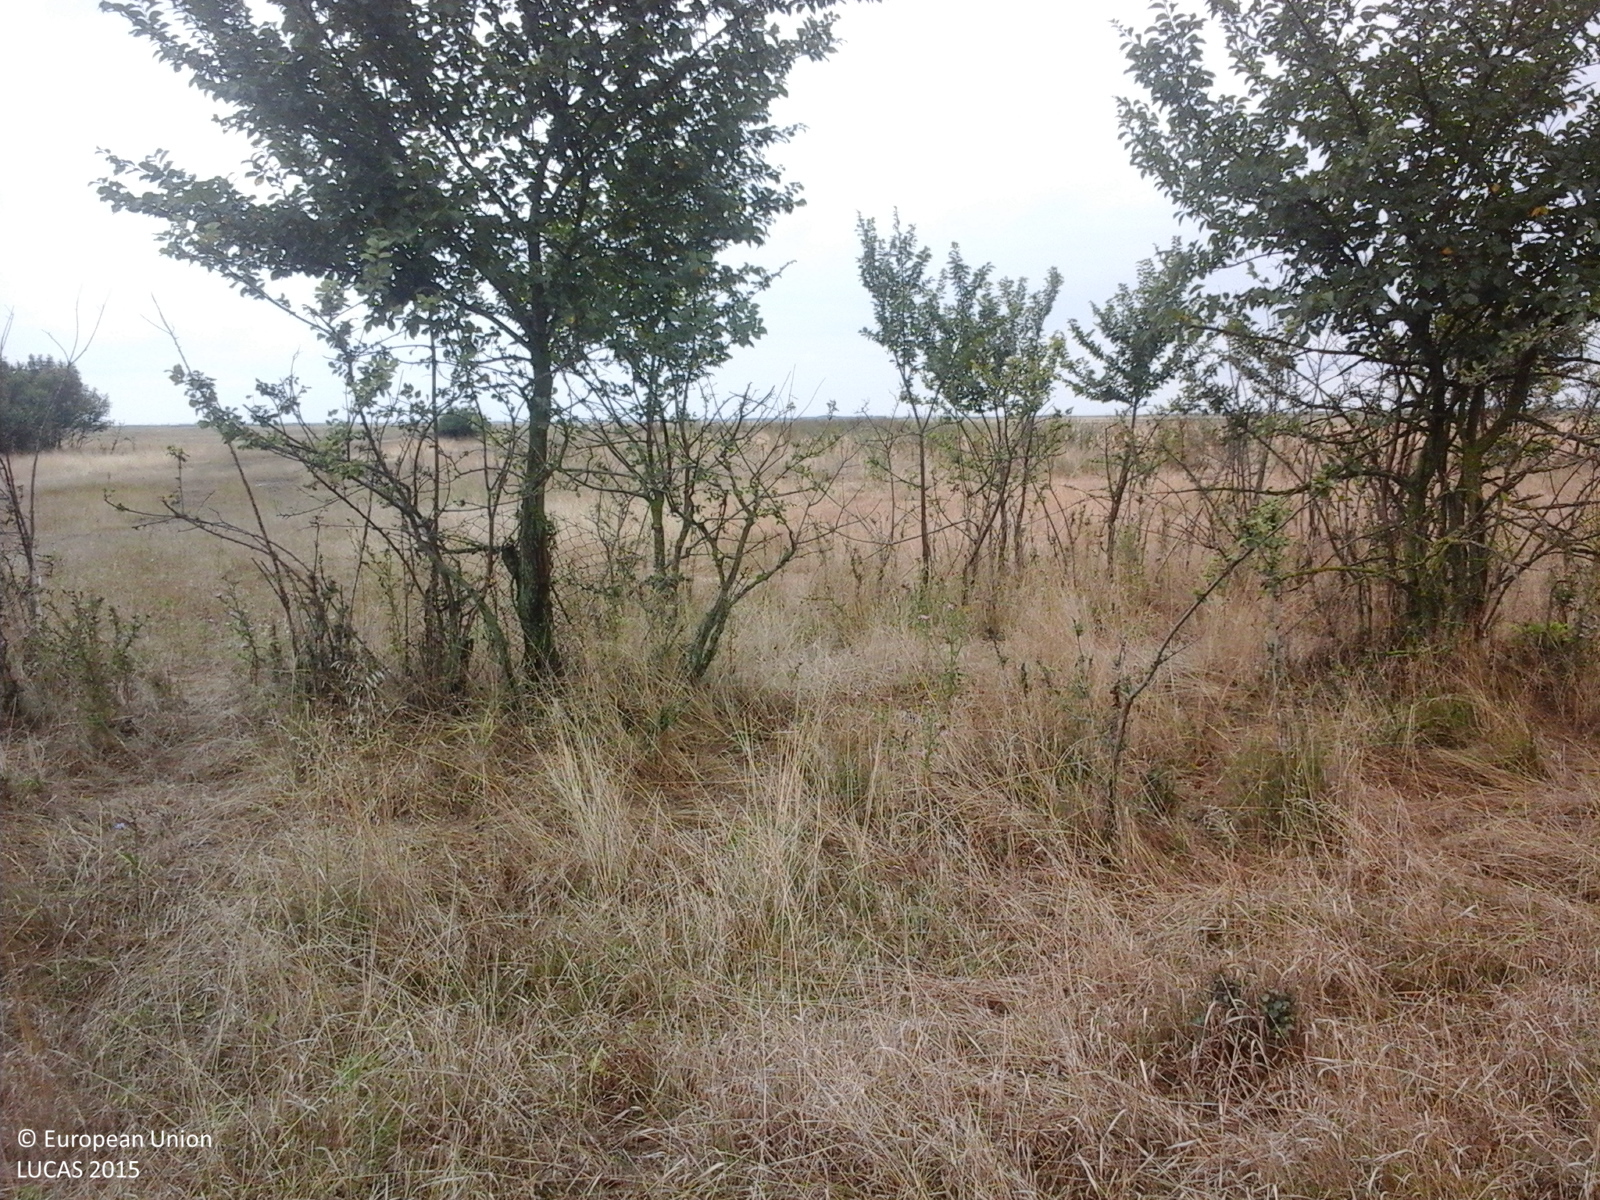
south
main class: Grassland
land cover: Spontaneously vegetated surfaces
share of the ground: > 75 %
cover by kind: herbaceous plants 100 %
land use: Semi-natural and natural areas not in use
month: August
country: RO
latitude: 46.0960
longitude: 20.4104
